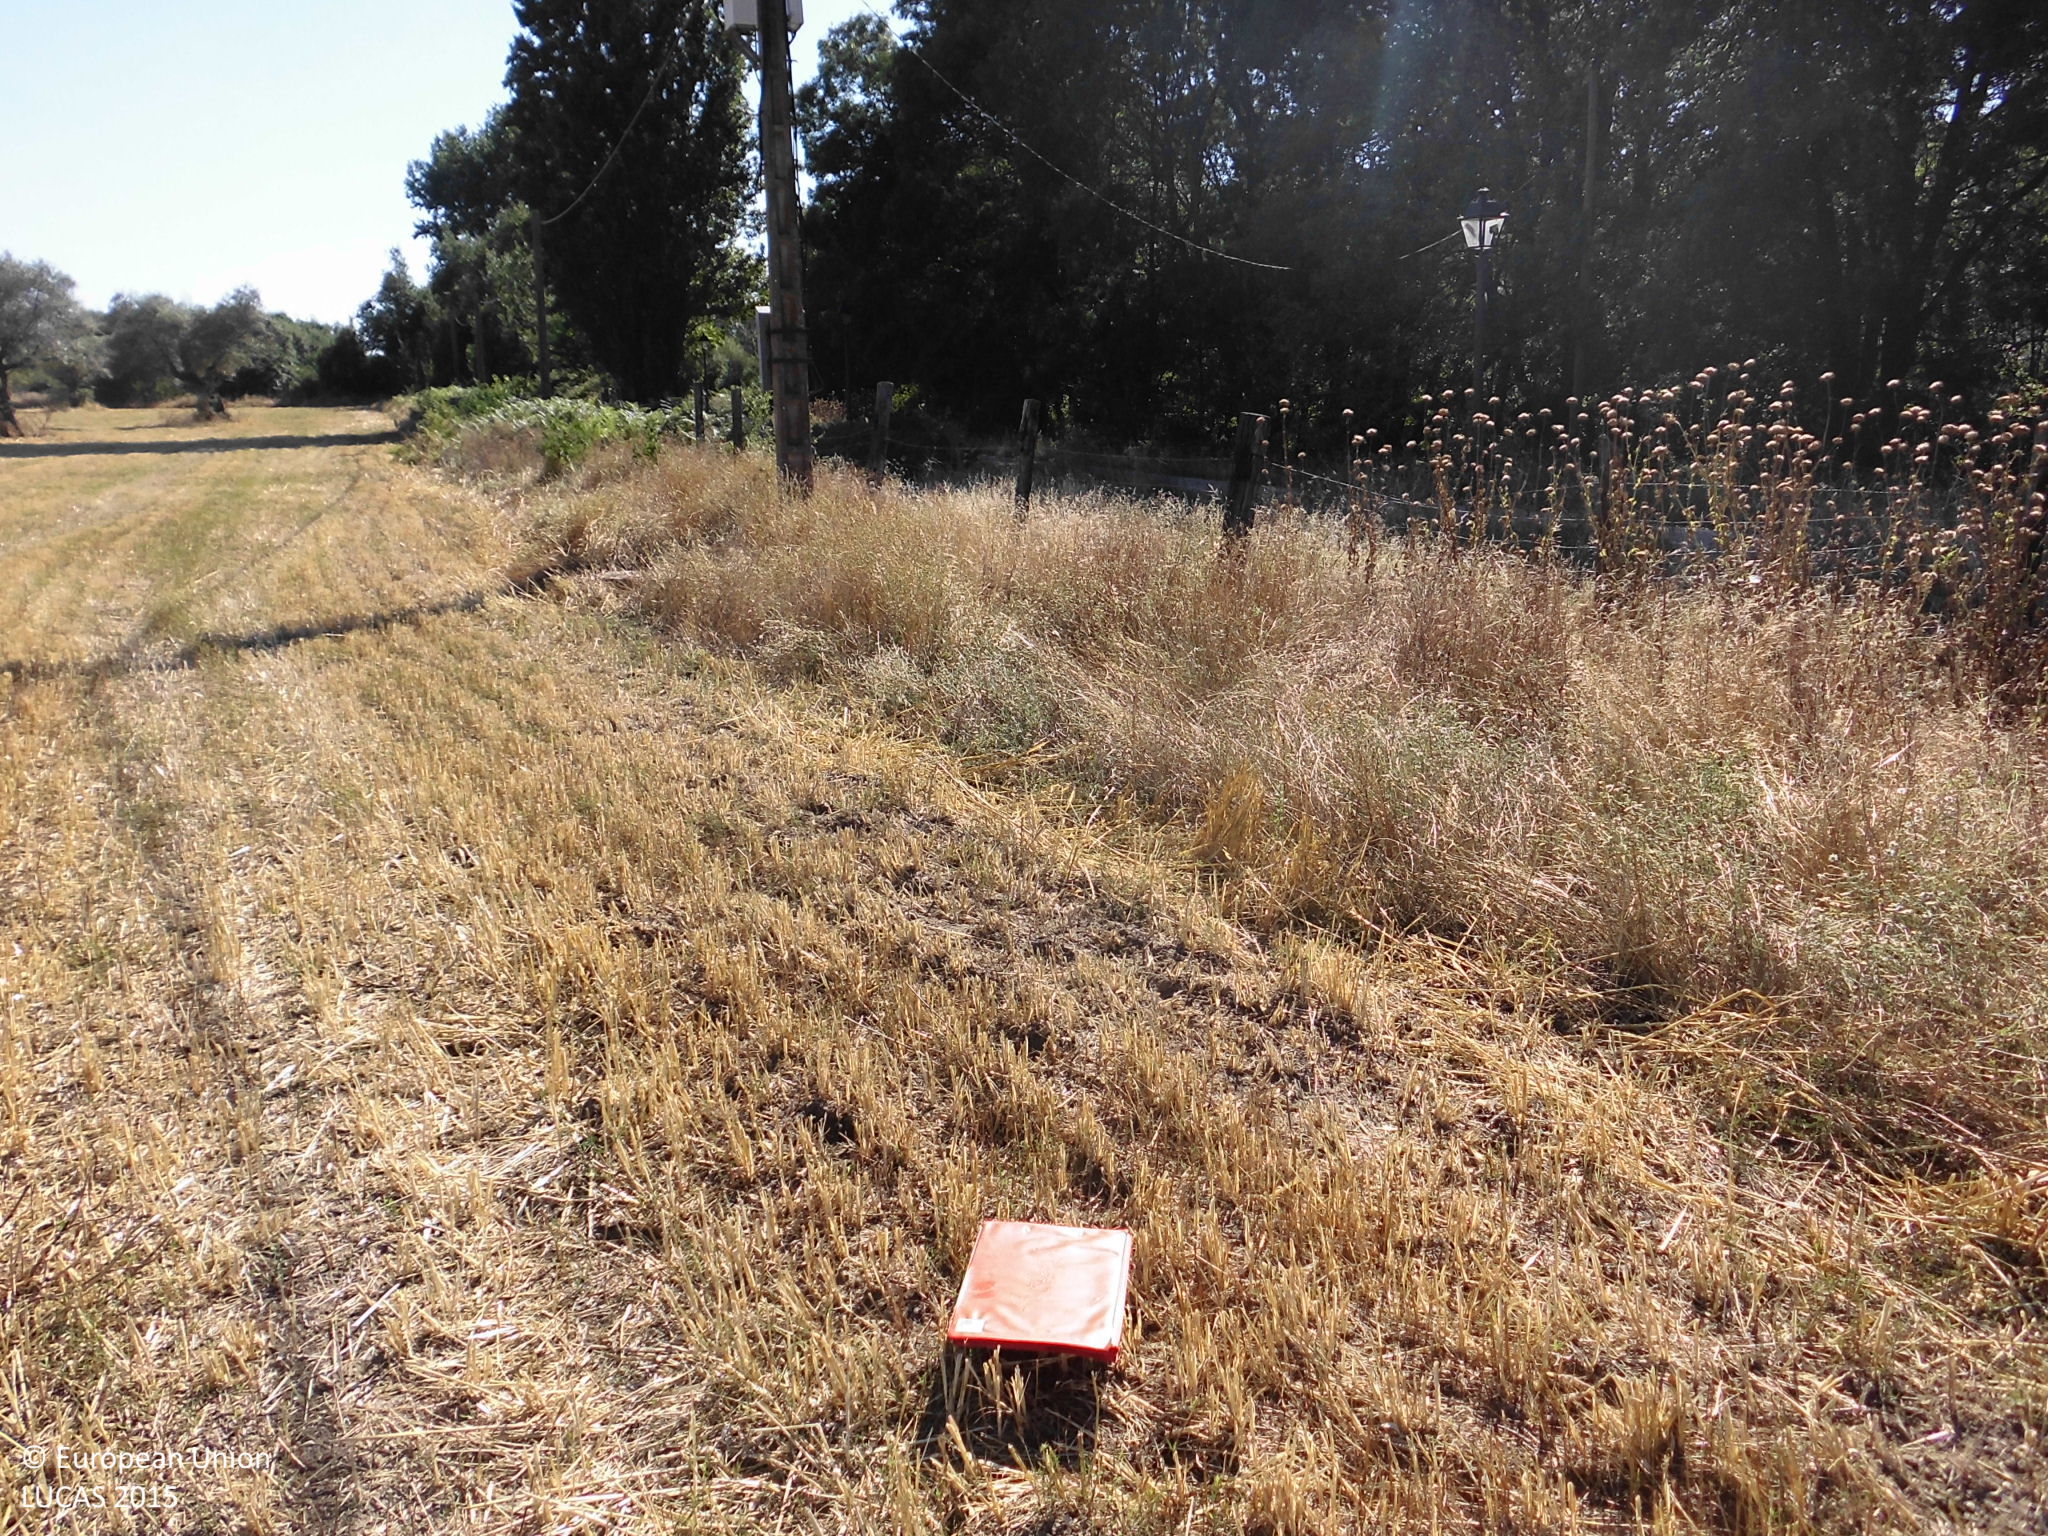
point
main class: Cropland
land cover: Oats
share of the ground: 50 - 75 %
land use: Agriculture (excluding fallow land and kitchen gardens)
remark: Harvested field
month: June
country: ES
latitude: 40.0373
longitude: -6.0685
